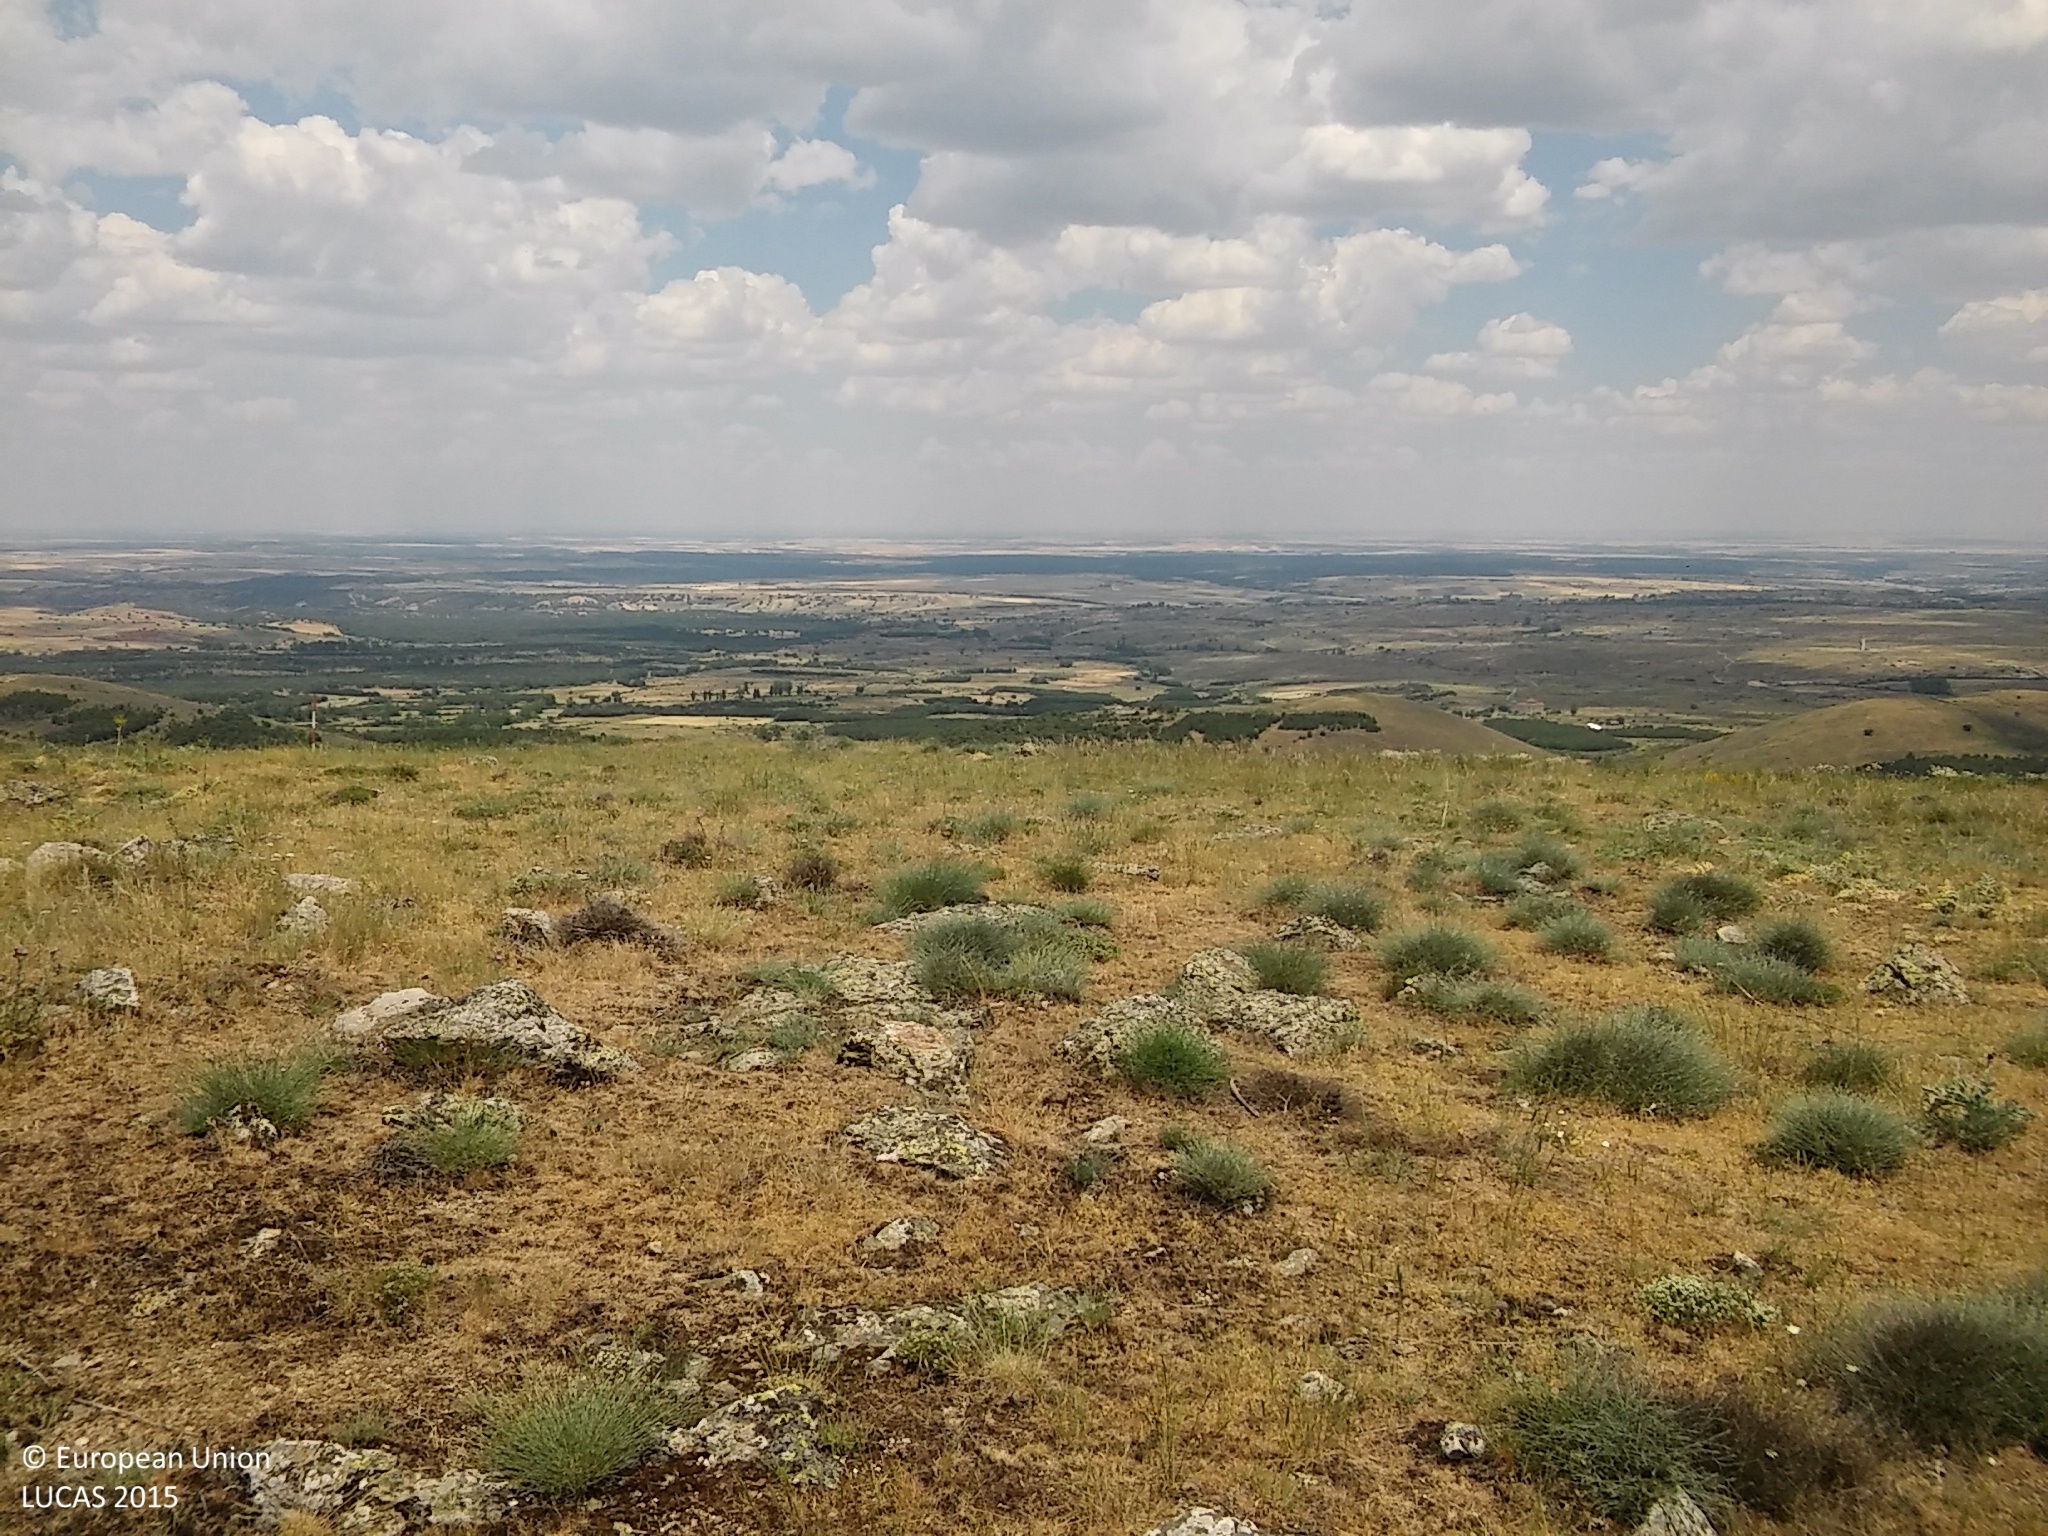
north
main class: Grassland
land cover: Grassland without tree/shrub cover
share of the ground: > 75 %
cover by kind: herbaceous plants 90 %, shrubs 5 %, consolidated bare surface 5 %
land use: Agriculture (excluding fallow land and kitchen gardens)
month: June
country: ES
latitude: 40.7159
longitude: -4.4350
